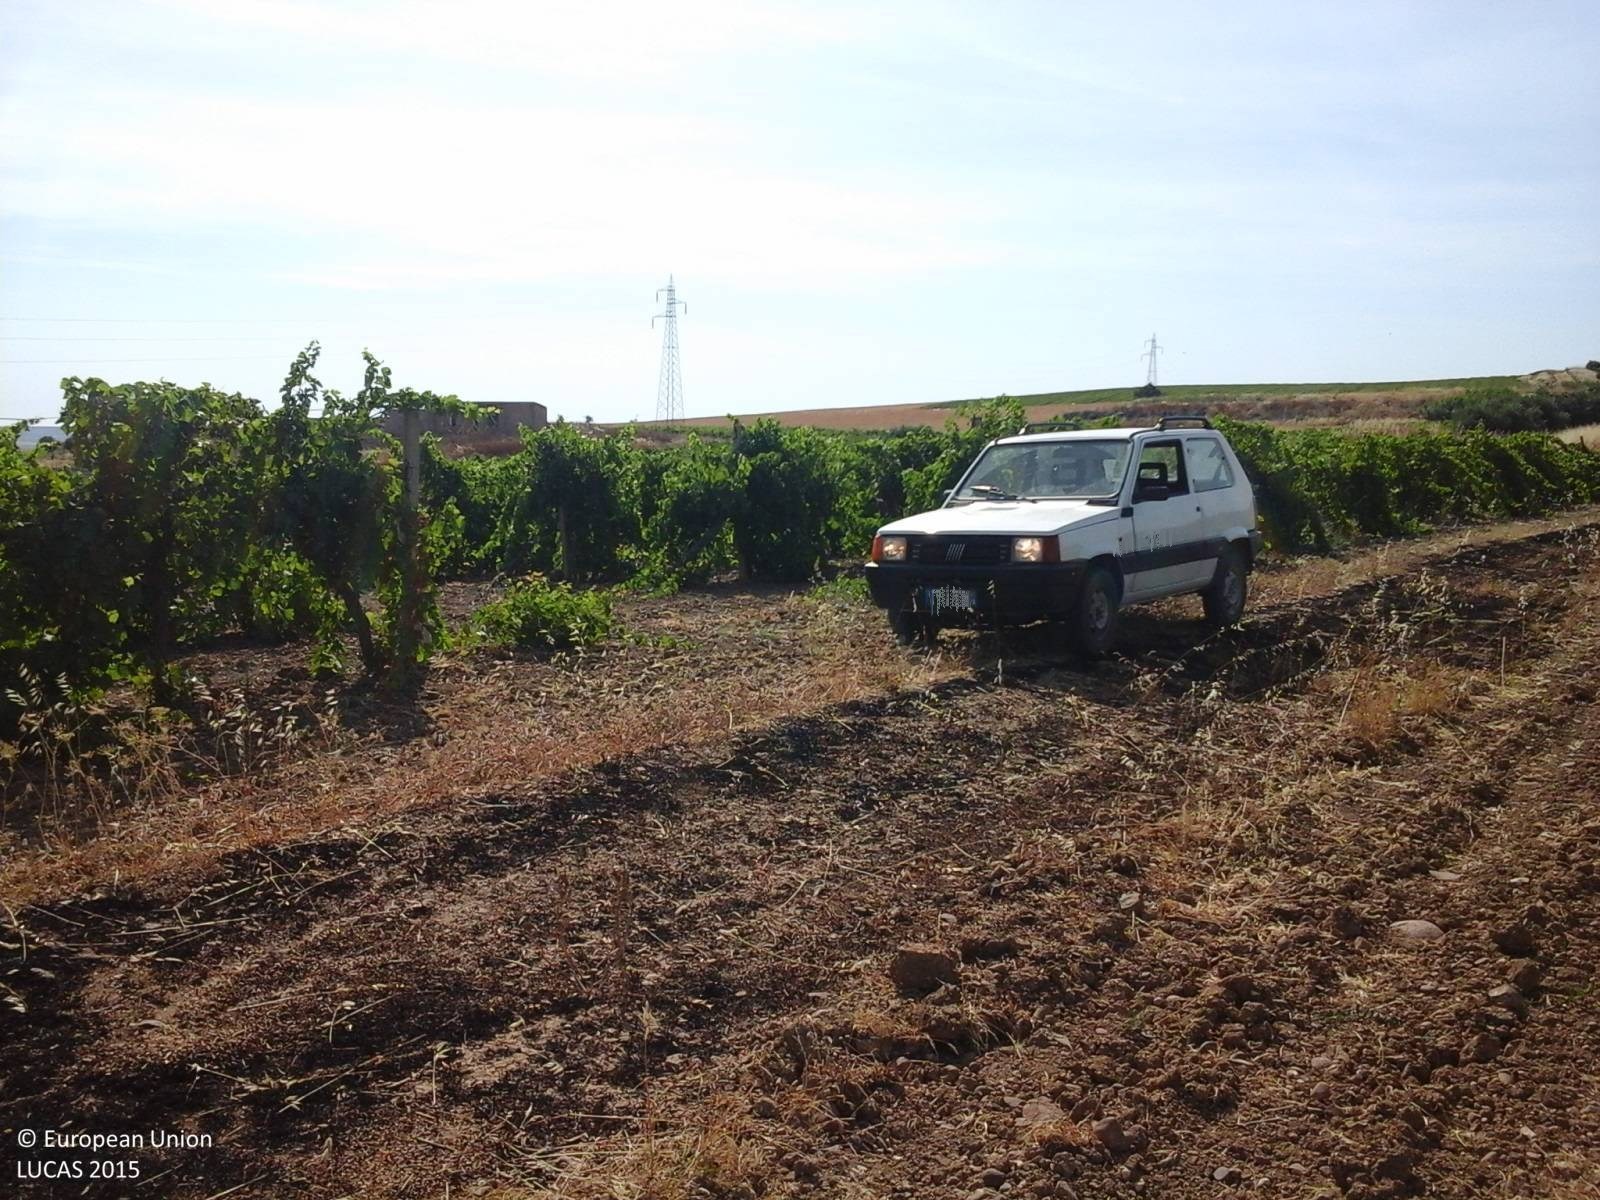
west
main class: Cropland
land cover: Vineyards
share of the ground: 50 - 75 %
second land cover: Other bare soil
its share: > 75 %
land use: Agriculture (excluding fallow land and kitchen gardens)
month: June
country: IT
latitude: 37.8190
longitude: 12.6725
